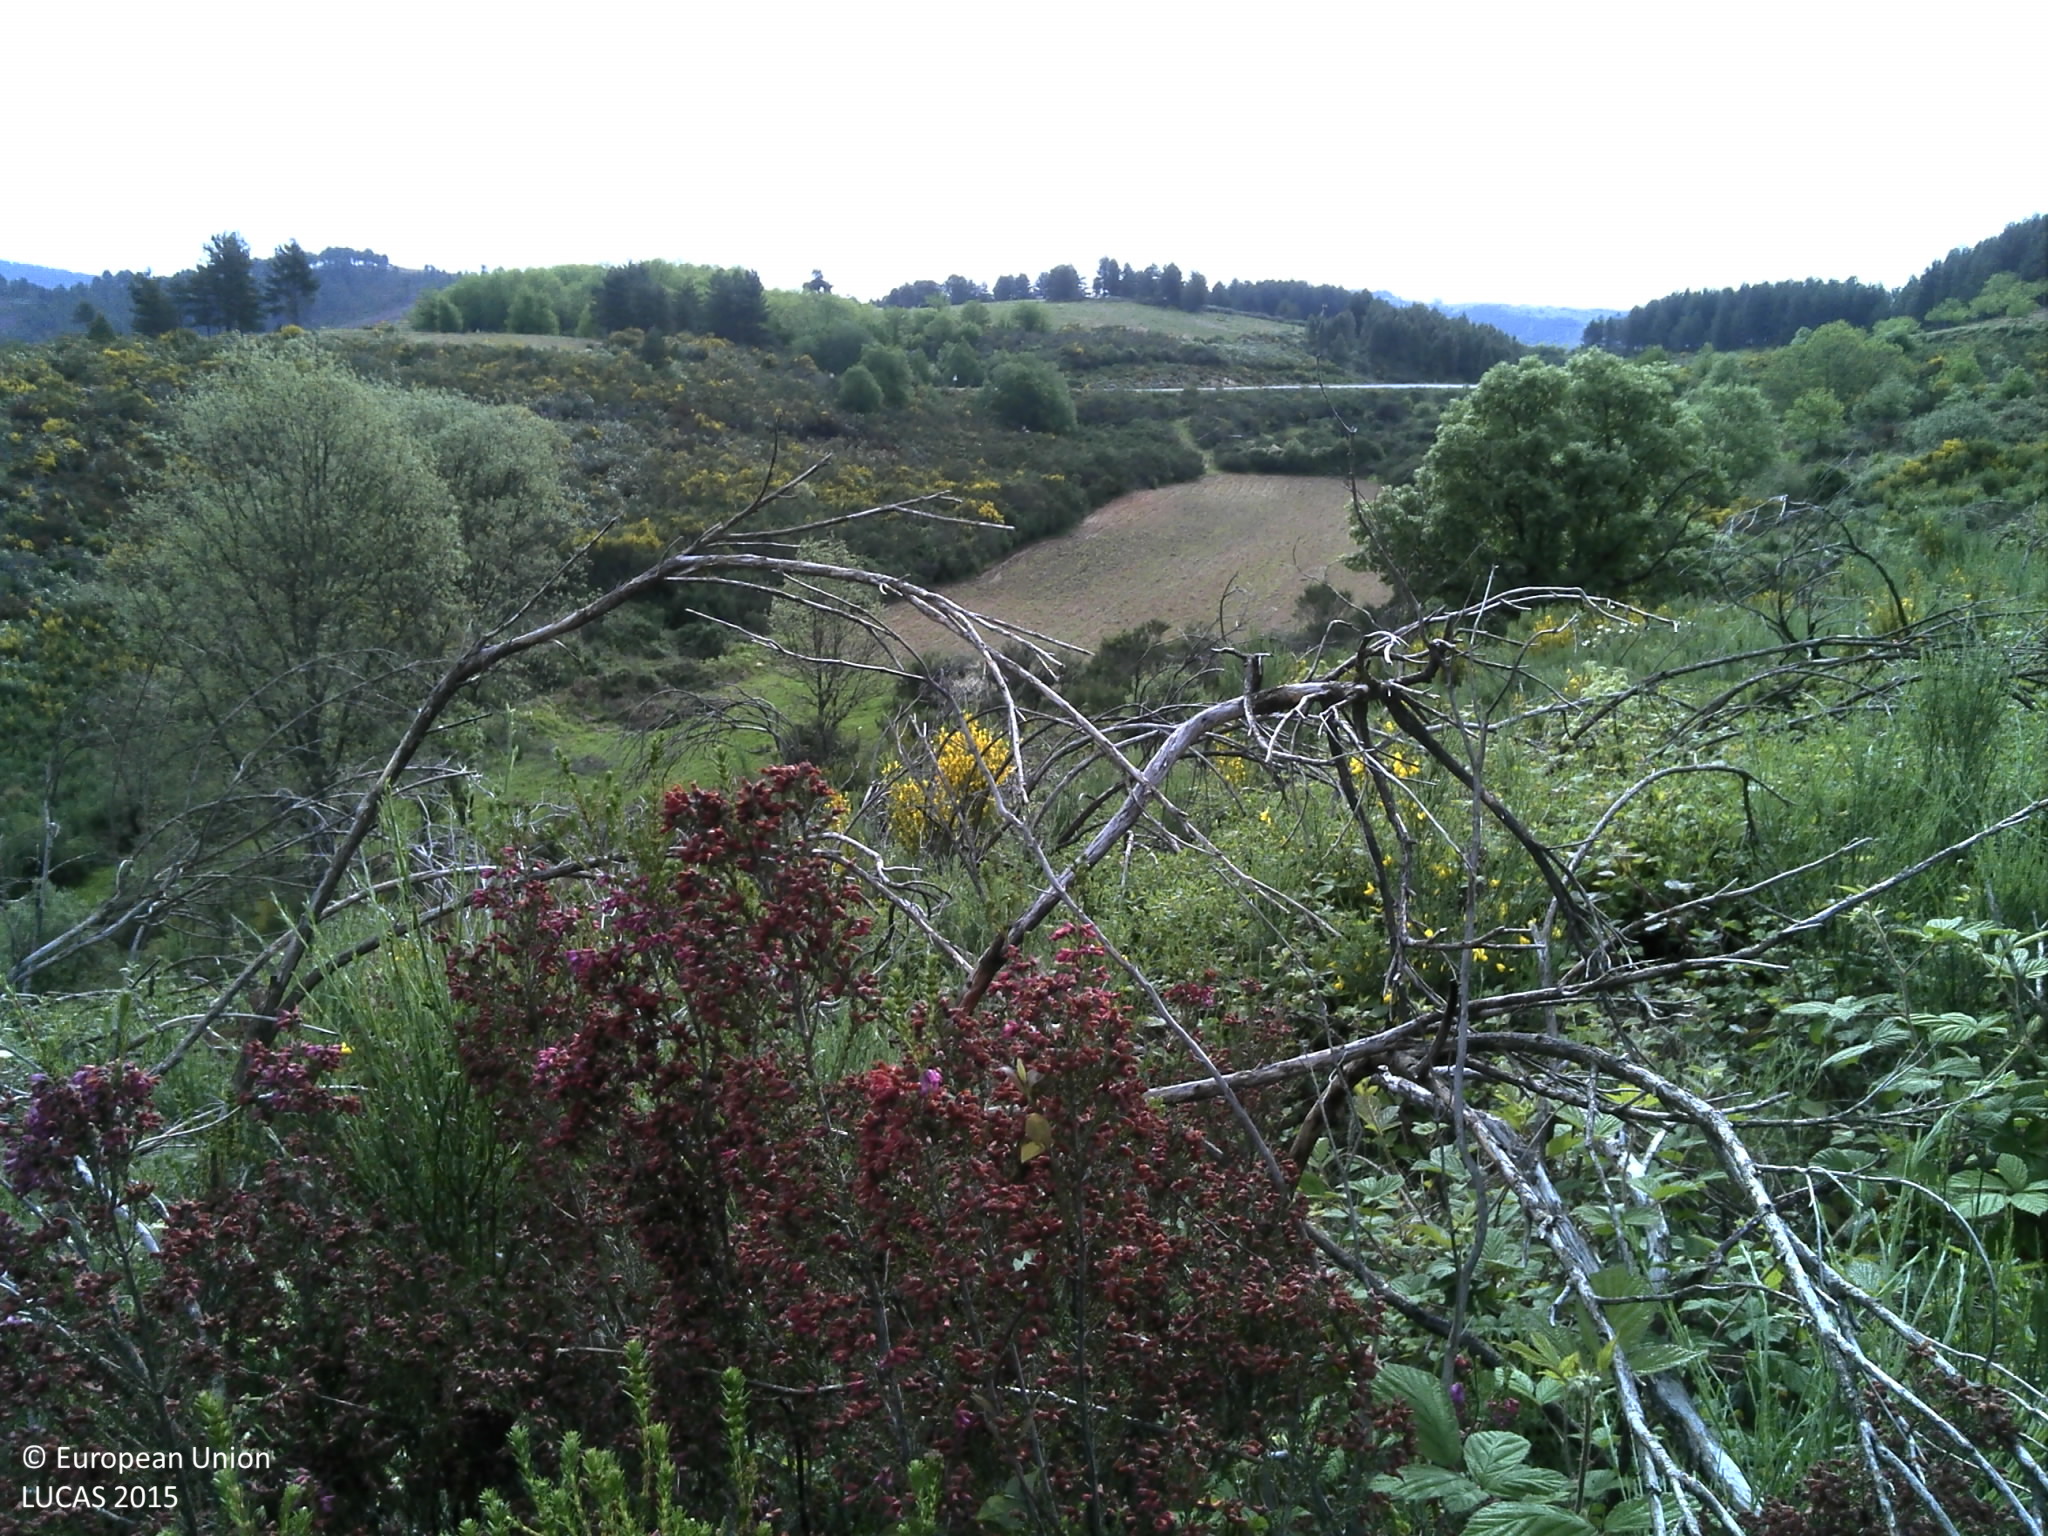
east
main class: Shrubland
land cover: Shrubland without tree cover
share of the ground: > 75 %
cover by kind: shrubs 75 %, herbaceous plants 15 %, unconsolidated bare surface 10 %
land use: Abandoned areas
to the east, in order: Shrubland without tree cover; Spontaneously vegetated surfaces; Shrubland without tree cover; Shrubland with sparse tree cover; Shrubland without tree cover; Grassland without tree/shrub cover; Spontaneously vegetated surfaces; Shrubland without tree cover; Tracks; Shrubland with sparse tree cover
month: May
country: PT
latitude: 41.6745
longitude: -6.9443
